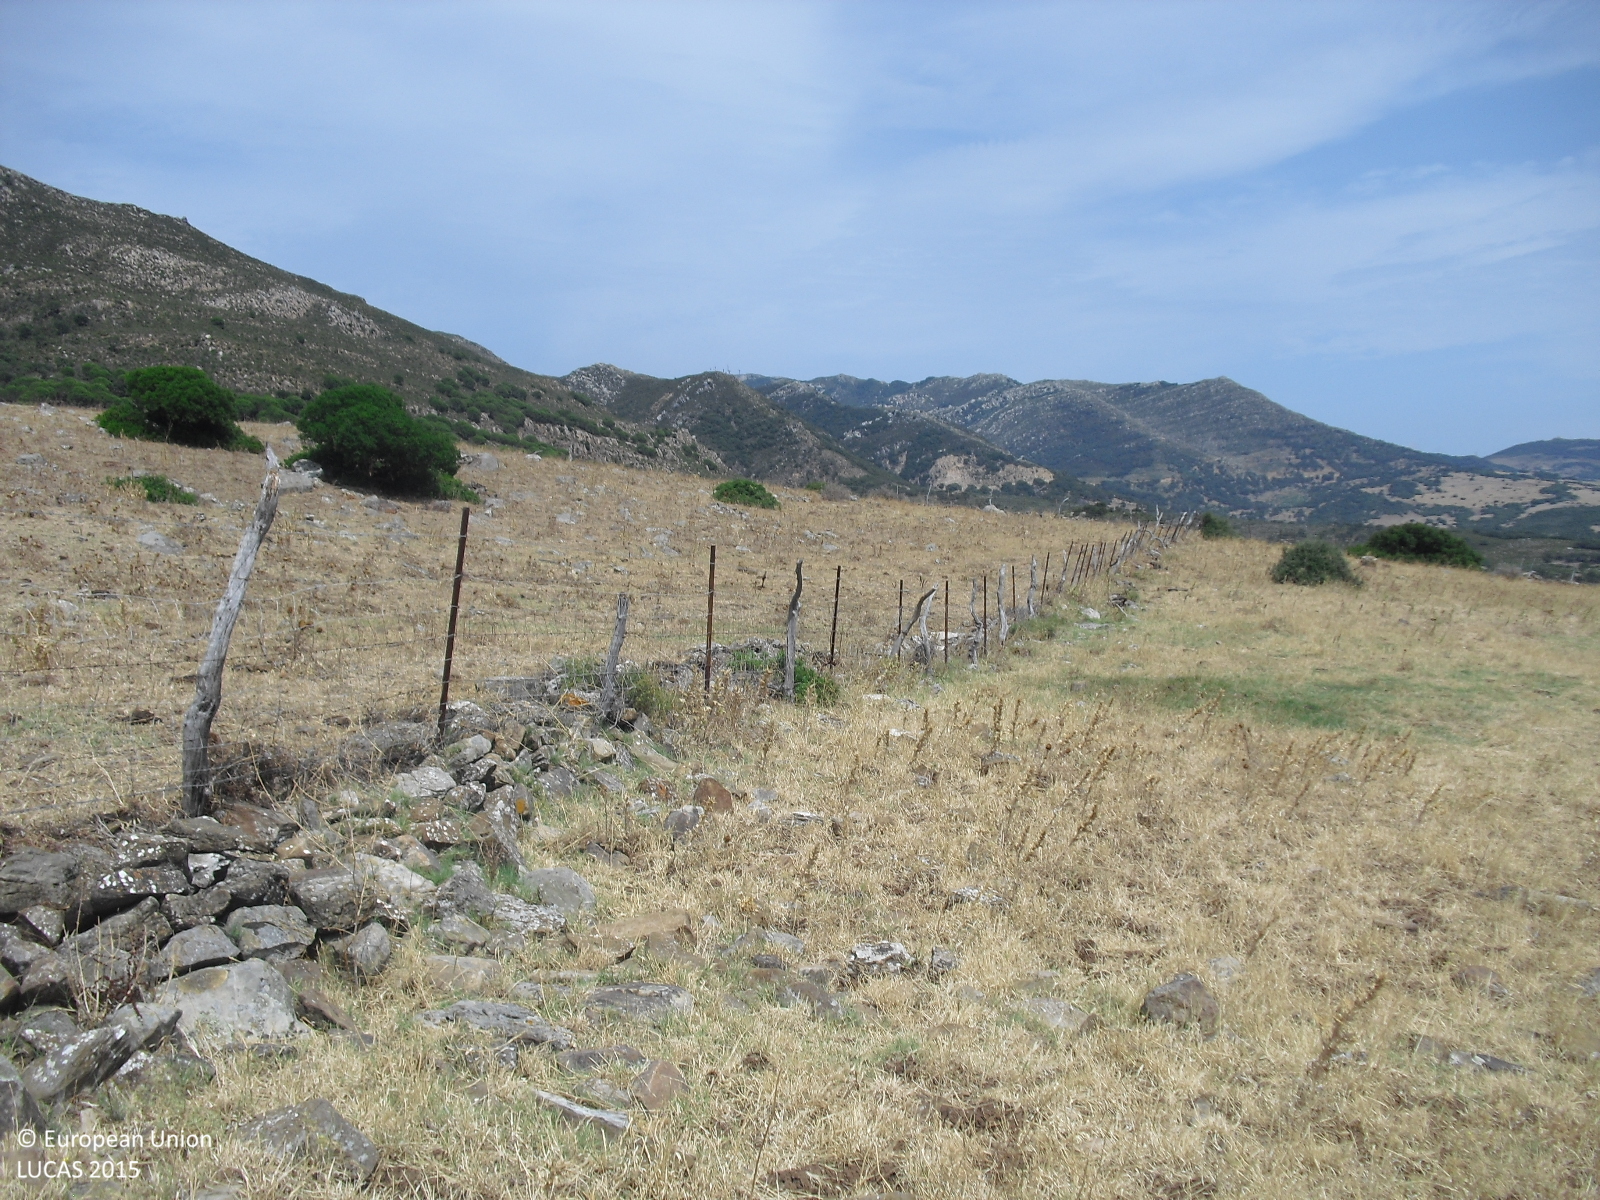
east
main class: Grassland
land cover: Grassland without tree/shrub cover
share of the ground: > 75 %
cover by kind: herbaceous plants 95 %, unconsolidated bare surface 5 %
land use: Agriculture (excluding fallow land and kitchen gardens)
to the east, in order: Grassland without tree/shrub cover; Fences; Grassland without tree/shrub cover; Grassland with sparse tree/shrub cover; Grassland without tree/shrub cover; Dry stone walls; Fences; Shrubland without tree cover; Tracks; Shrubland without tree cover; Other structural elements; Broadleaved woodland
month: July
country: ES
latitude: 36.1014
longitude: -5.5988
